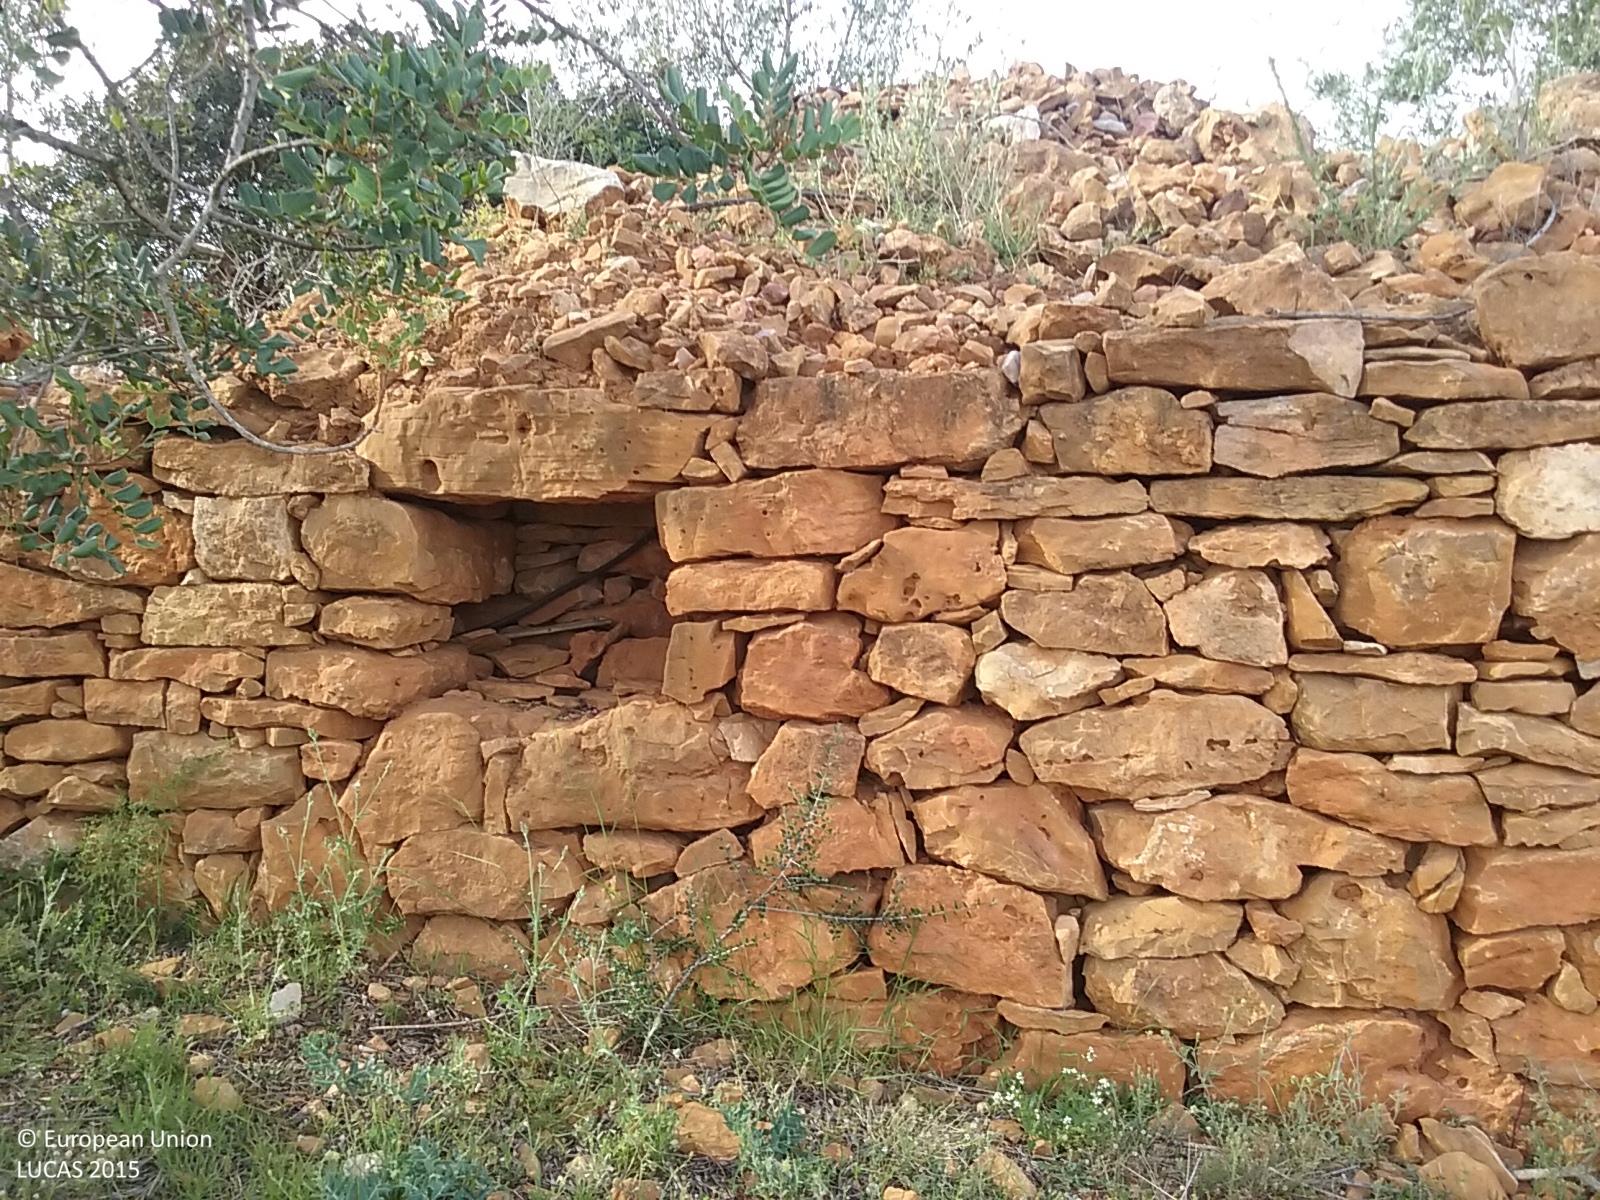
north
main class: Cropland
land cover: Olive groves
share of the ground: 25 - 50 %
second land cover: Grassland without tree/shrub cover
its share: 50 - 75 %
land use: Agriculture (excluding fallow land and kitchen gardens)
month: May
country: ES
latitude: 40.2175
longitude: 0.0680
